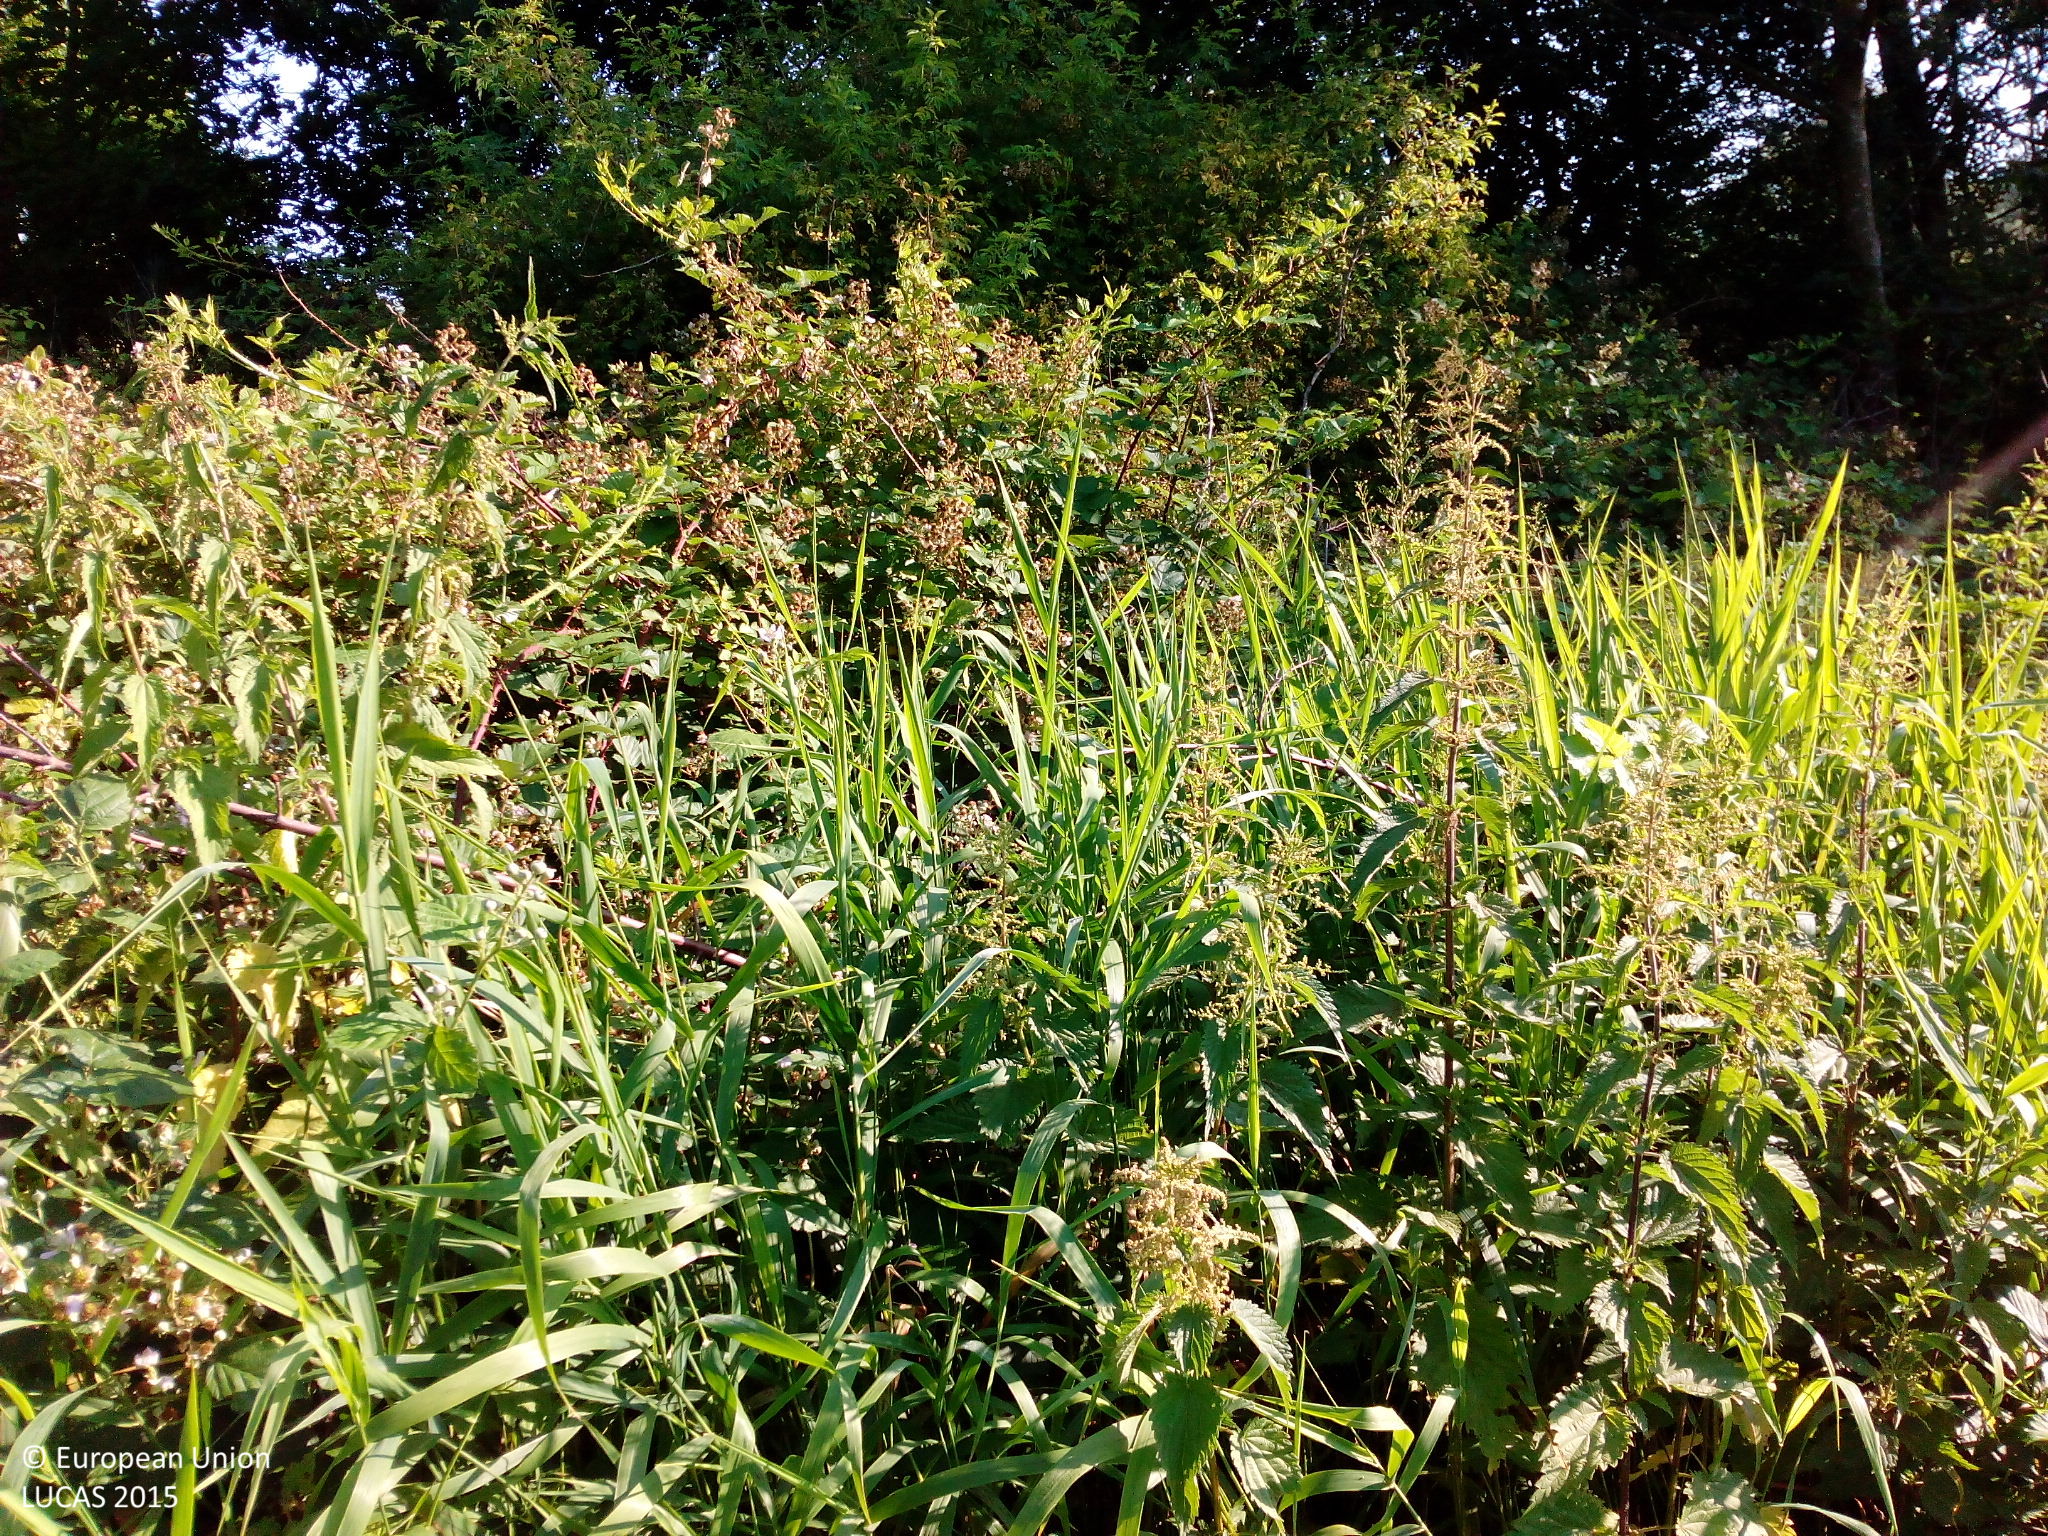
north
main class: Grassland
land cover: Grassland without tree/shrub cover
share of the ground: > 75 %
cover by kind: herbaceous plants 100 %
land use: Agriculture (excluding fallow land and kitchen gardens)
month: July
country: DE
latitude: 49.1398
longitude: 7.1082
